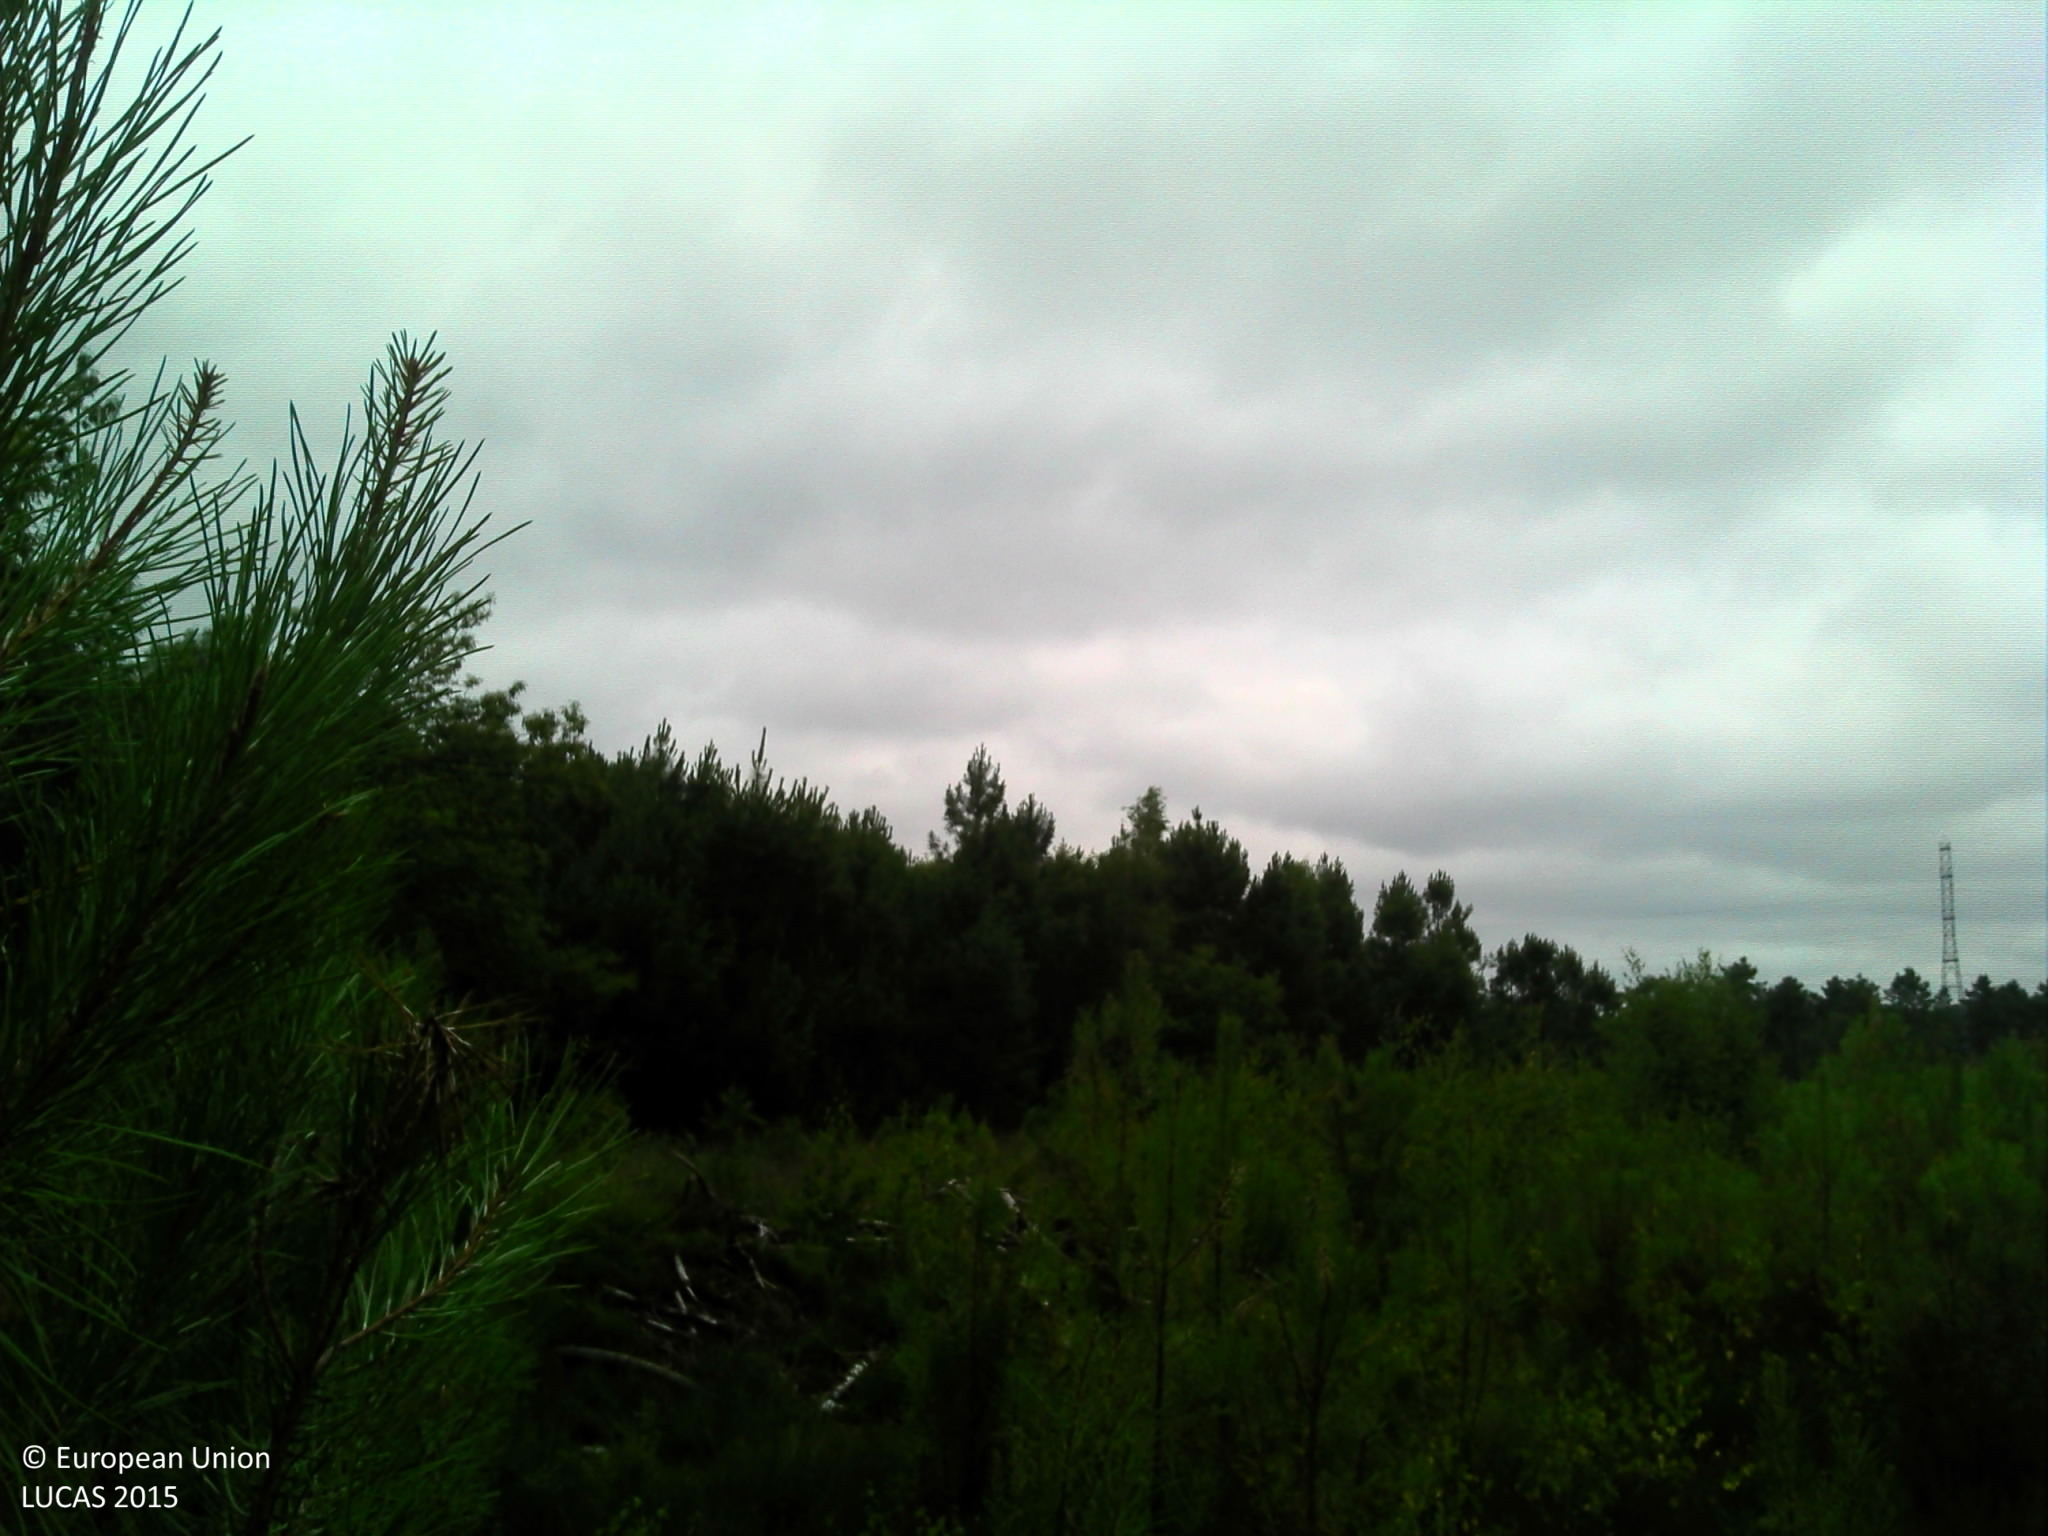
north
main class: Woodland
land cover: Pine dominated coniferous woodland
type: exotic forest
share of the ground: 50 - 75 %
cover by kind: coniferous forest trees 50 %, herbaceous plants 30 %, shrubs 20 %
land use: Forestry
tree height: < 5 m
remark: Nursery
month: July
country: FR
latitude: 47.8776
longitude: 0.4161
